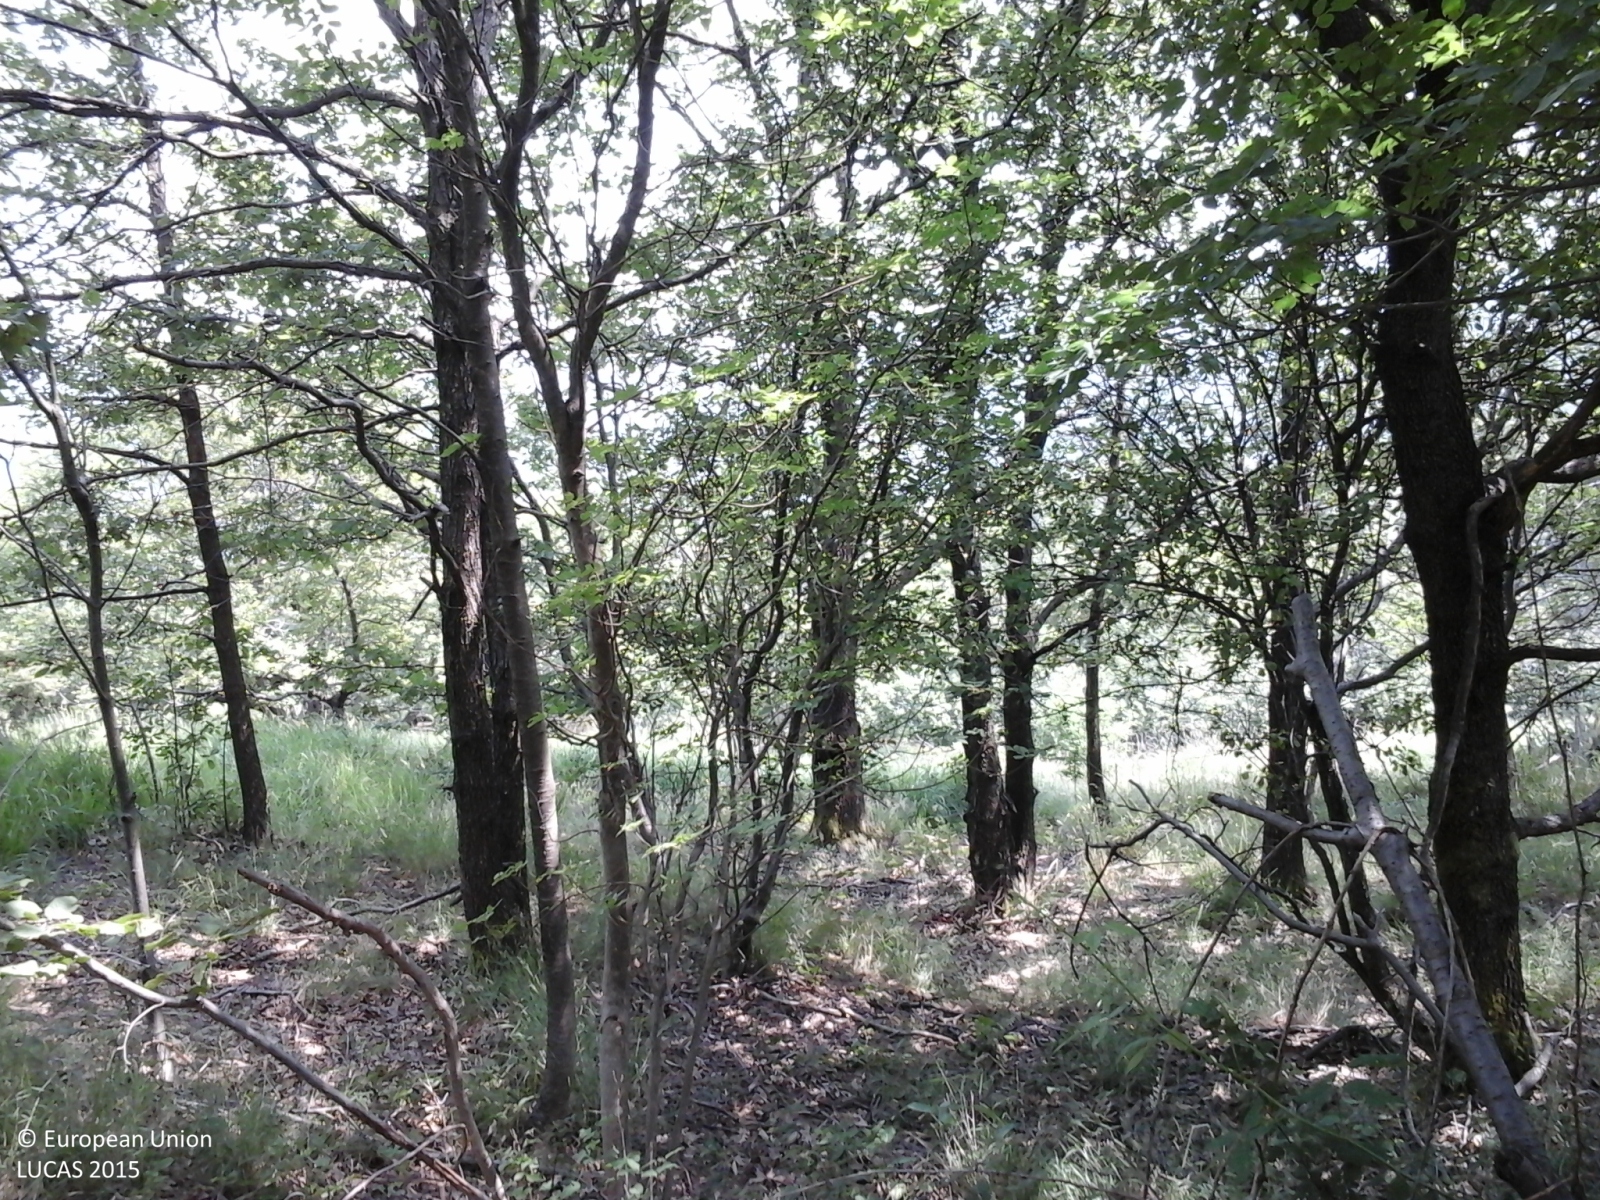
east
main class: Woodland
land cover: Broadleaved woodland
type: thermophilous deciduous forest
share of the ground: > 75 %
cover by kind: broadleaved forest trees 95 %, coniferous forest trees 5 %
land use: Forestry
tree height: > 5 m
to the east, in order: Broadleaved woodland; Grassland with sparse tree/shrub cover; Electric lines; Grassland with sparse tree/shrub cover; Other mixed woodland; Shrubland with sparse tree cover; Broadleaved woodland; Inland fresh running water; Broadleaved woodland; Ditches and canals; Broadleaved woodland
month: June
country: IT
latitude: 44.5950
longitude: 8.7052
